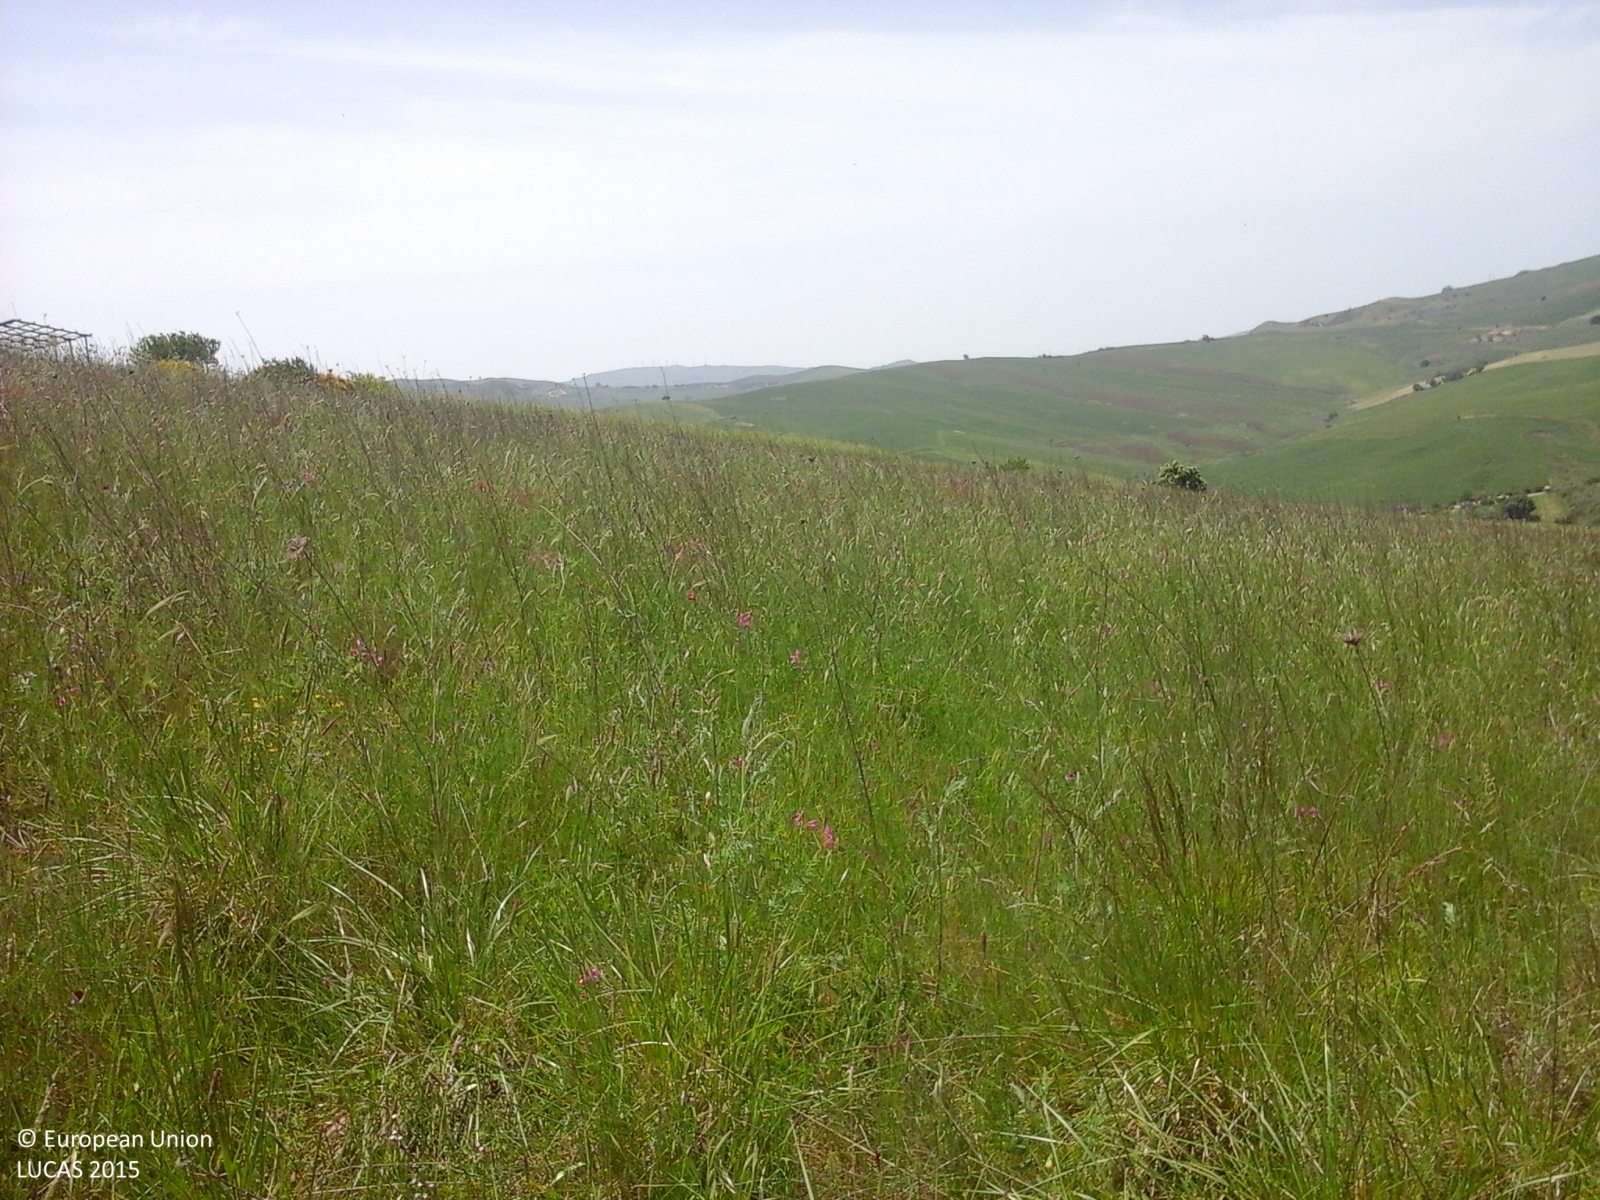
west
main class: Grassland
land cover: Spontaneously vegetated surfaces
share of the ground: > 75 %
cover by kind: herbaceous plants 100 %
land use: Fallow land
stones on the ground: < 10 %
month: May
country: IT
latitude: 37.7704
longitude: 14.0465
